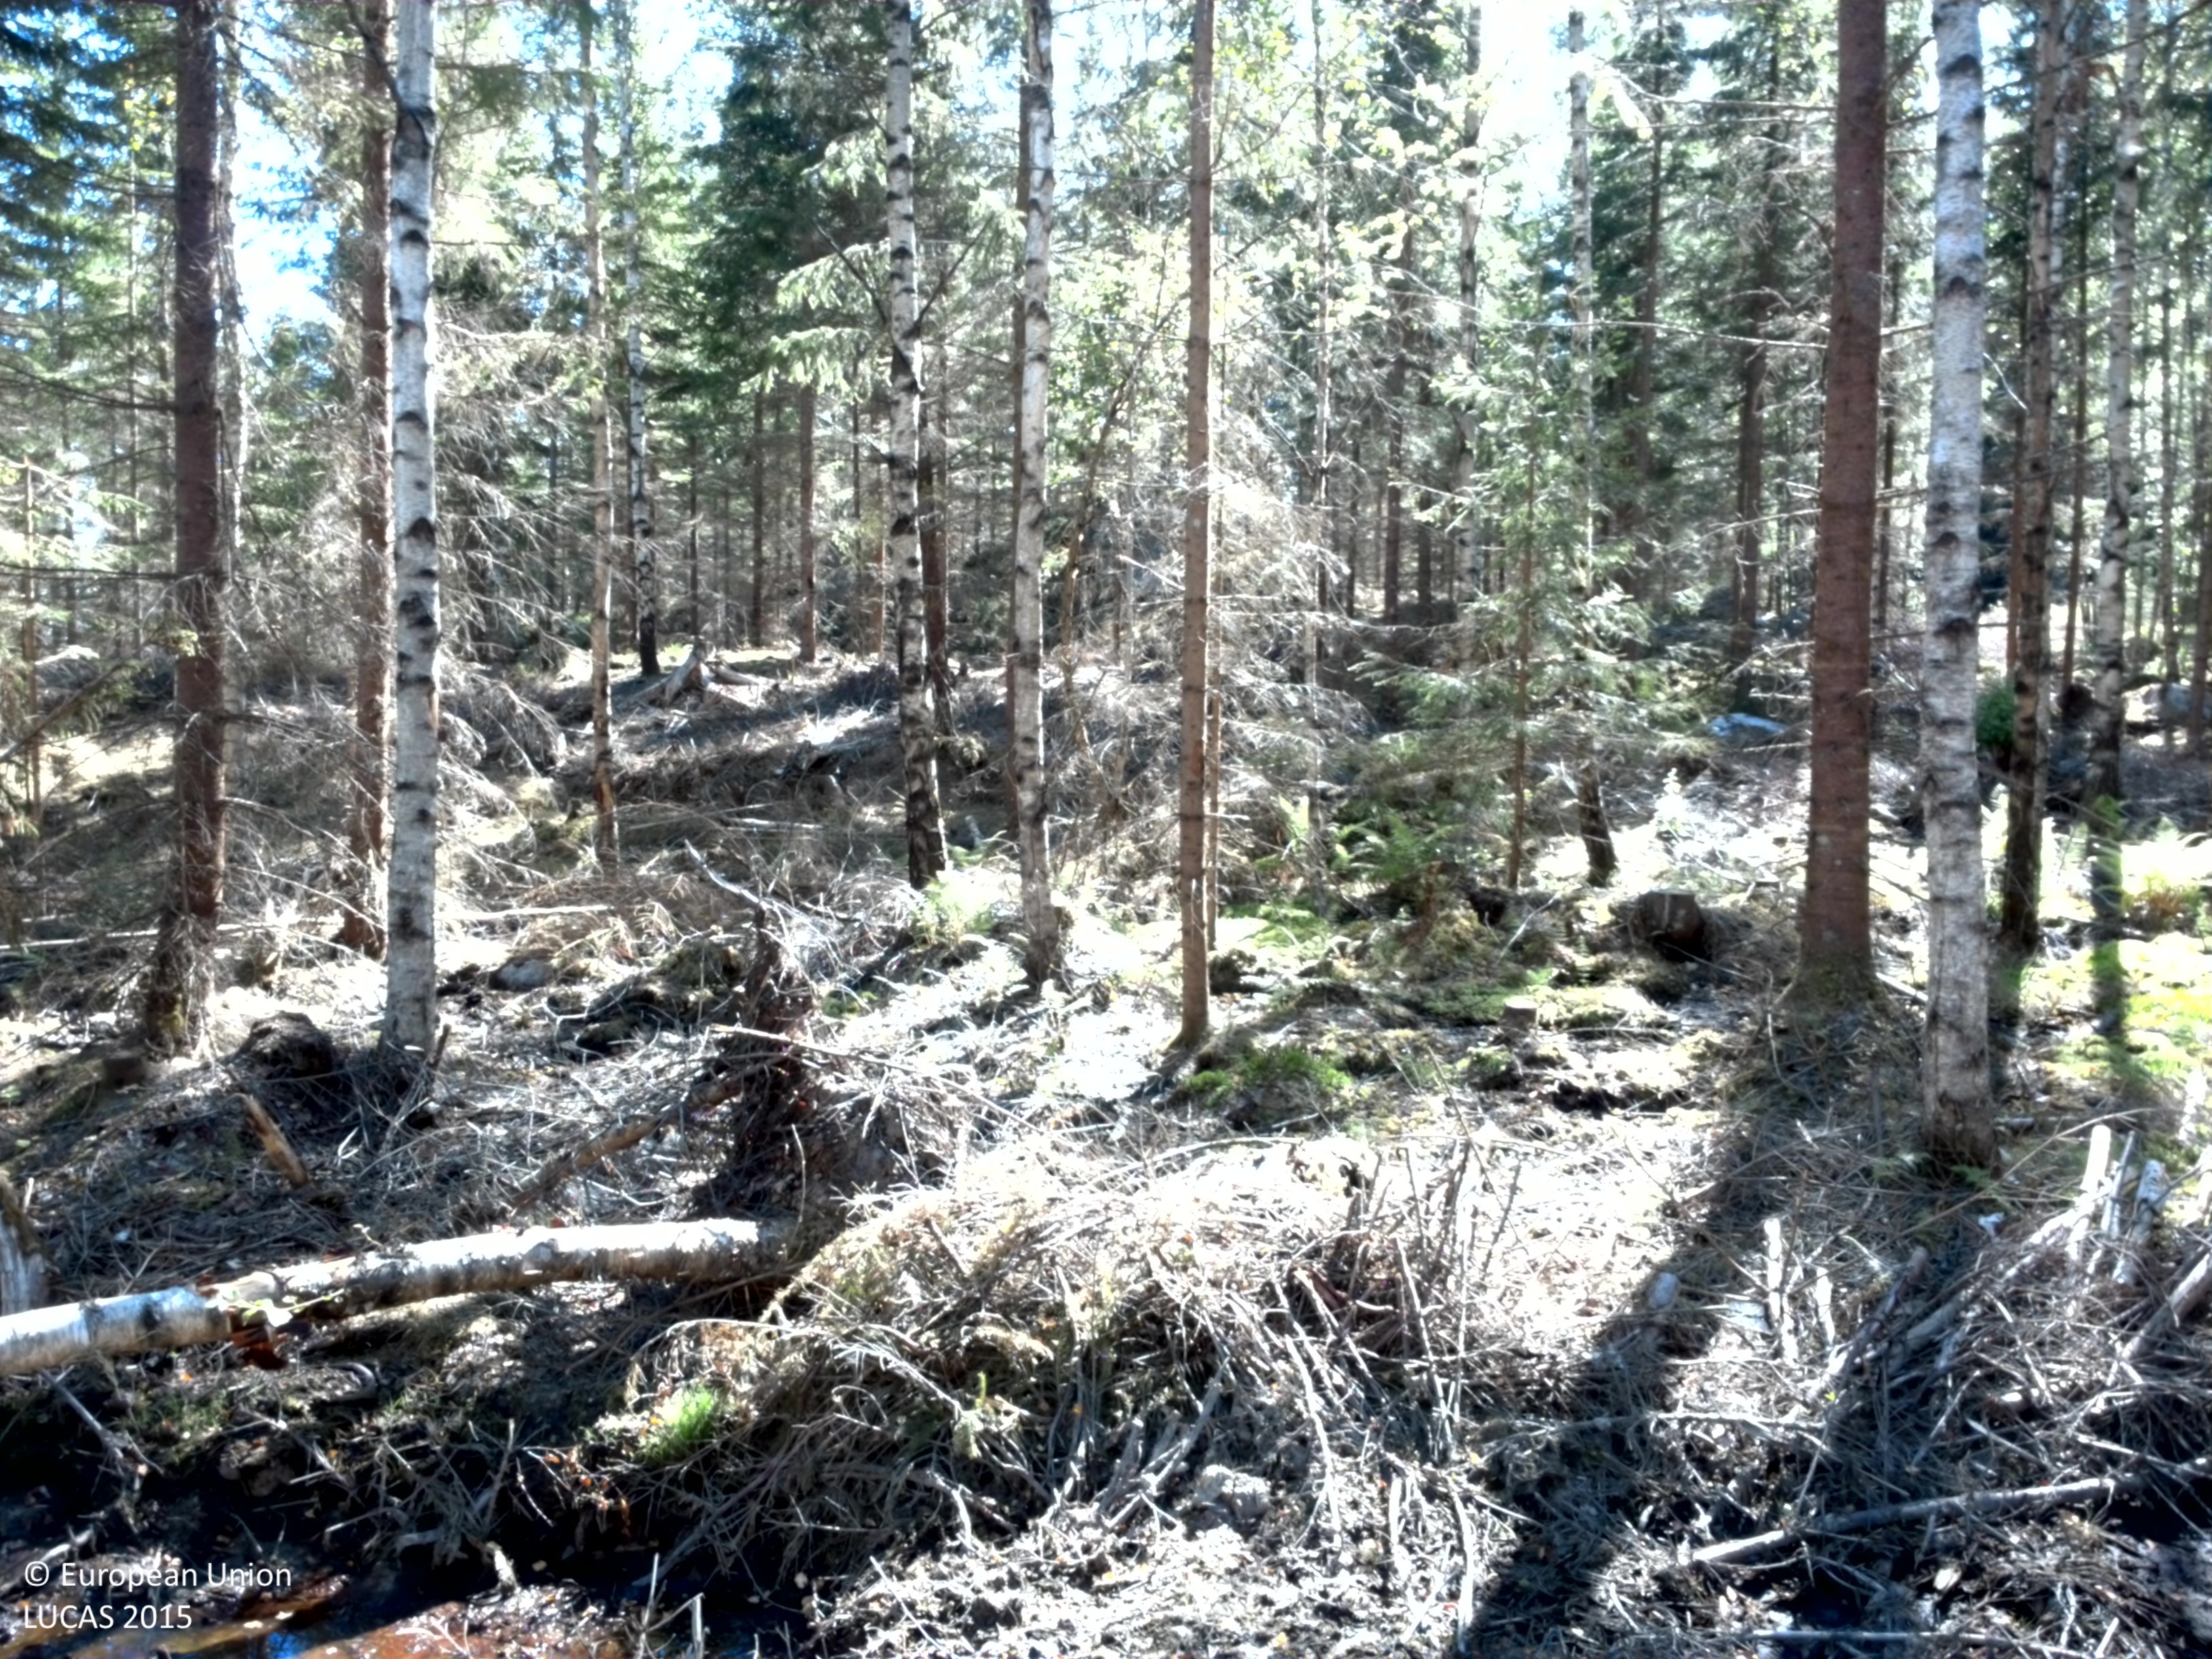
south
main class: Woodland
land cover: Spruce dominated mixed woodland
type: boreal forest
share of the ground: 50 - 75 %
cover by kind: coniferous forest trees 30 %, broadleaved forest trees 20 %, lichens and mosses 15 %, consolidated bare surface 10 %, shrubs 5 %
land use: Forestry
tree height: > 5 m
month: August
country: SE
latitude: 59.7415
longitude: 14.1360
